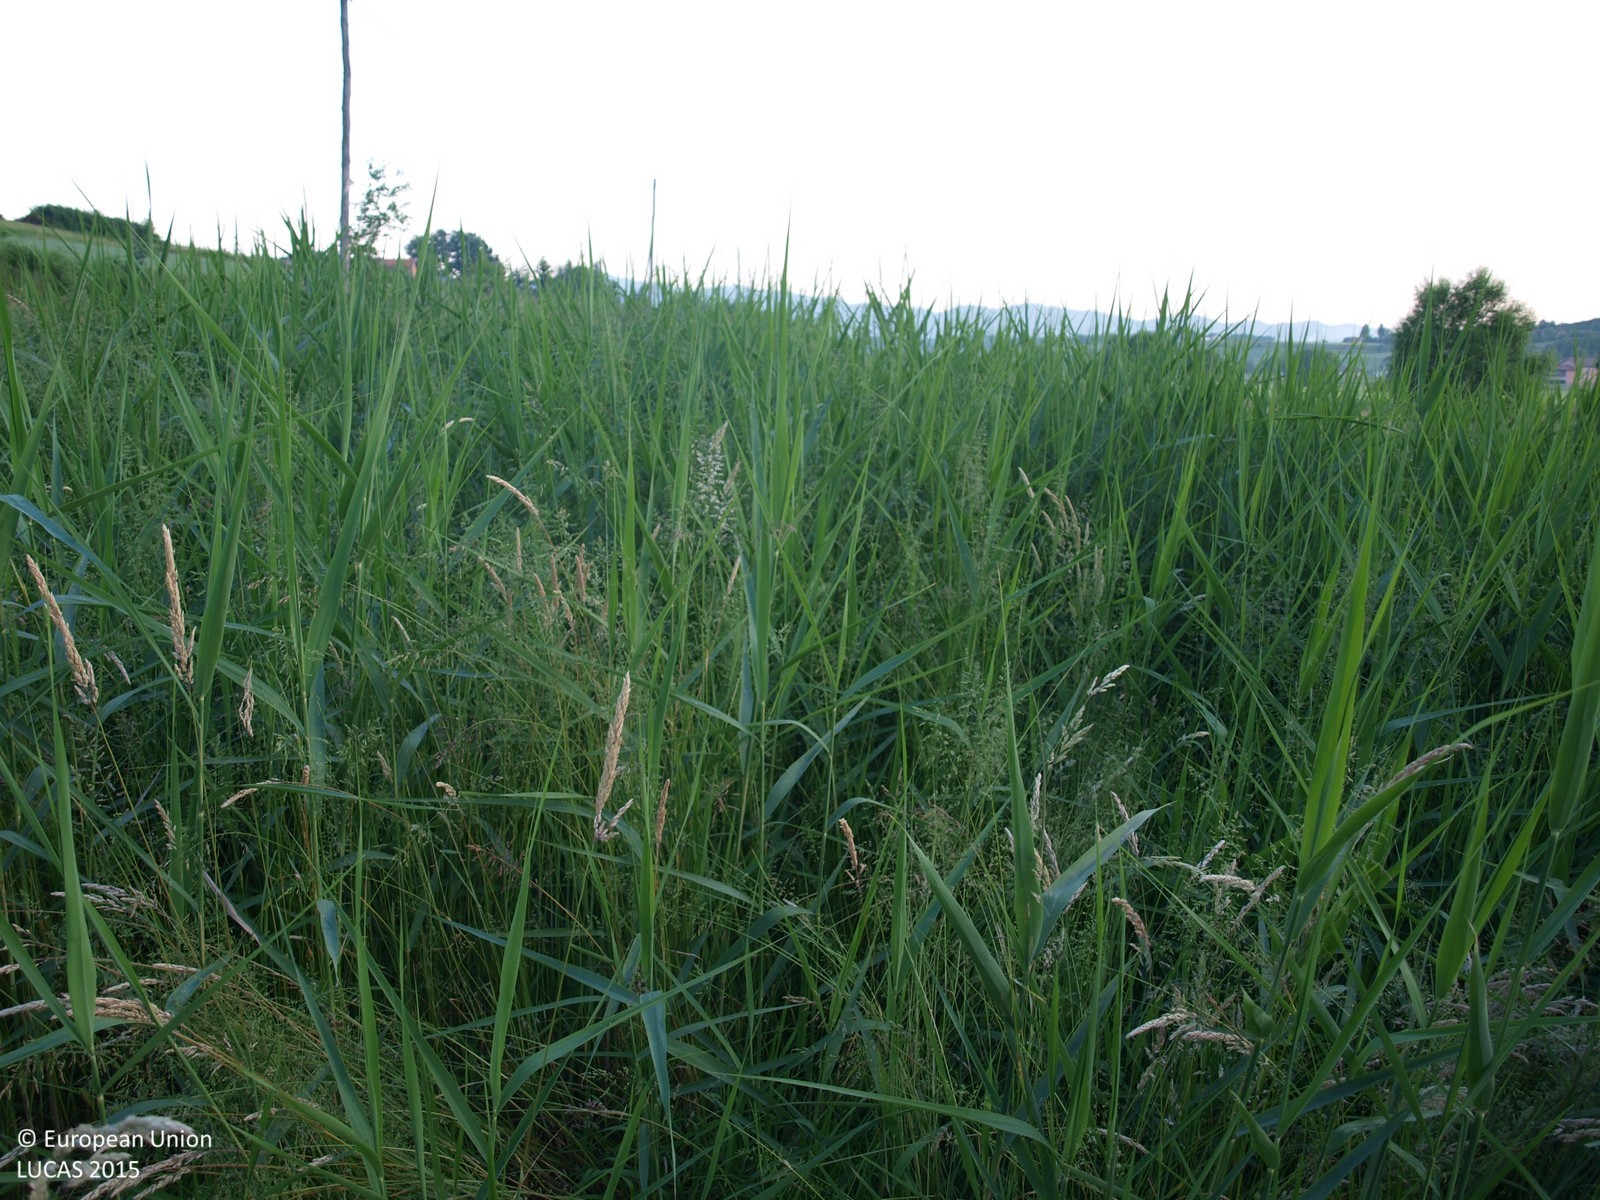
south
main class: Grassland
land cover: Grassland without tree/shrub cover
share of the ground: > 75 %
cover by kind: herbaceous plants 100 %
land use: Residential
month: June
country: HR
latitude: 46.3027
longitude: 16.1147
